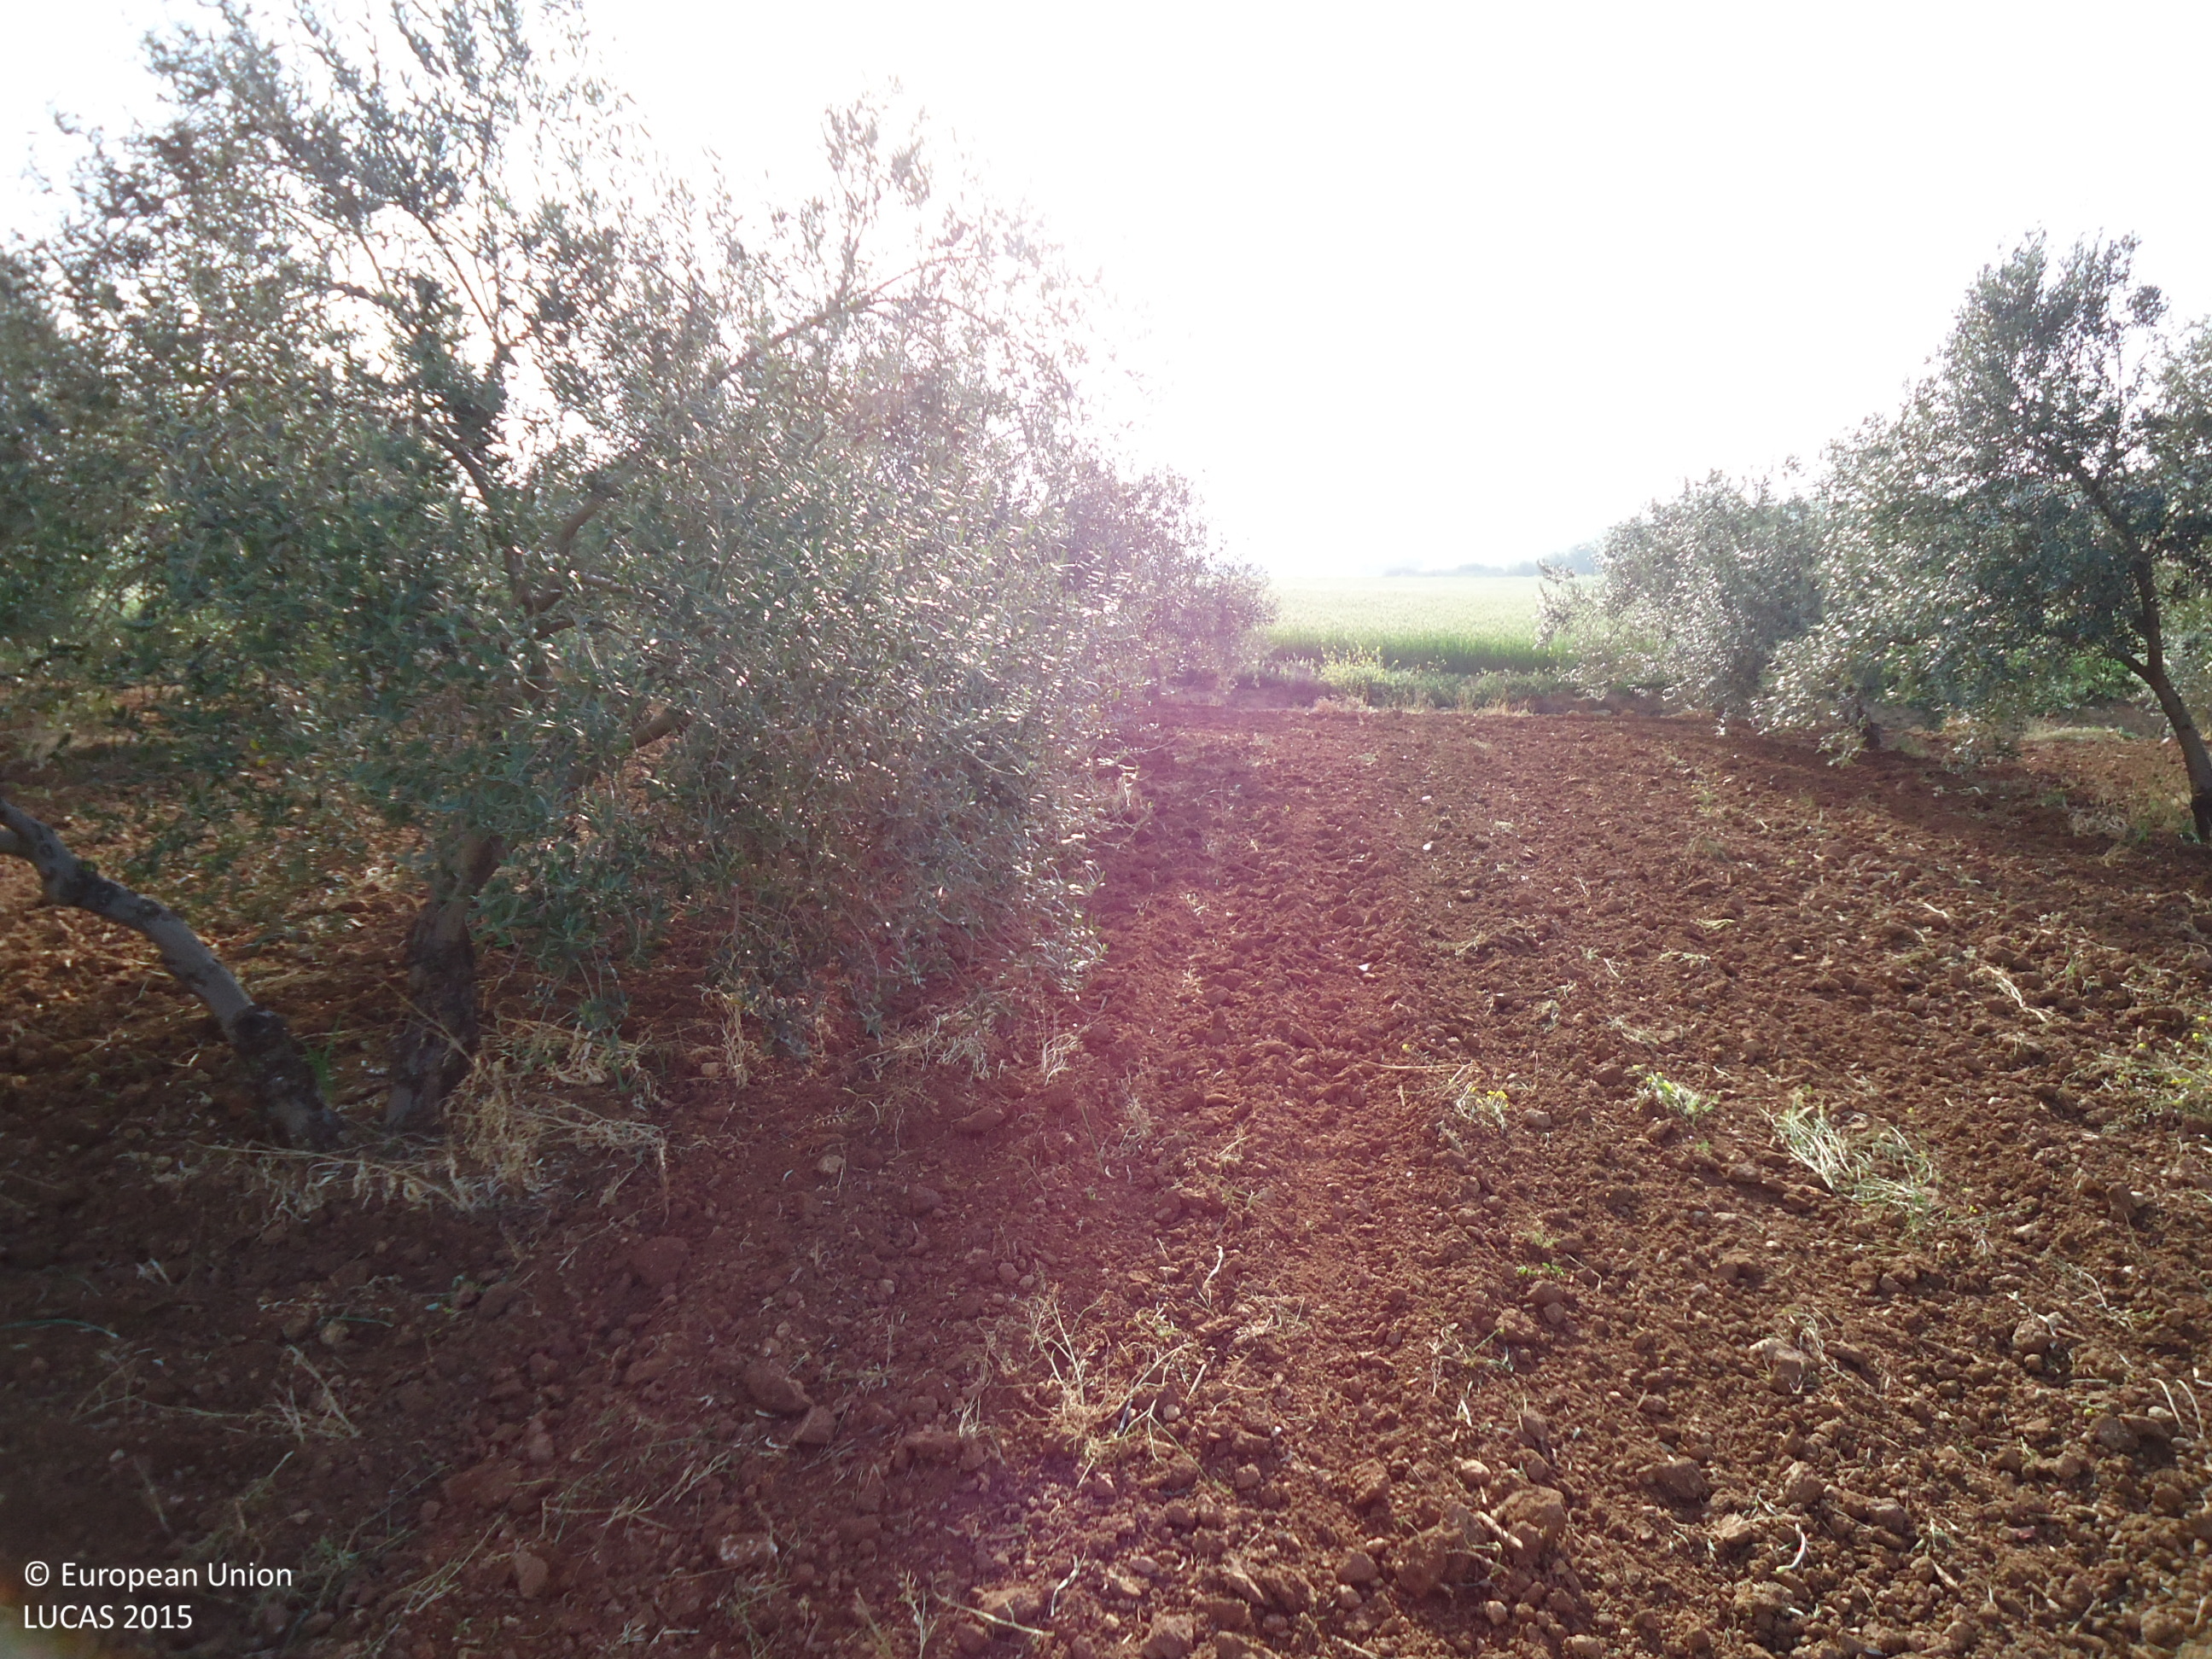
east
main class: Cropland
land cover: Olive groves
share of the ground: 25 - 50 %
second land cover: Other bare soil
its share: > 75 %
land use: Agriculture (excluding fallow land and kitchen gardens)
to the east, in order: Olive groves; Other bare soil; Other structural elements; Grass margins; Durum wheat; Electric lines; Durum wheat; Other structural elements; Fences; Durum wheat
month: April
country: ES
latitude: 37.2015
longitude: -4.8418
